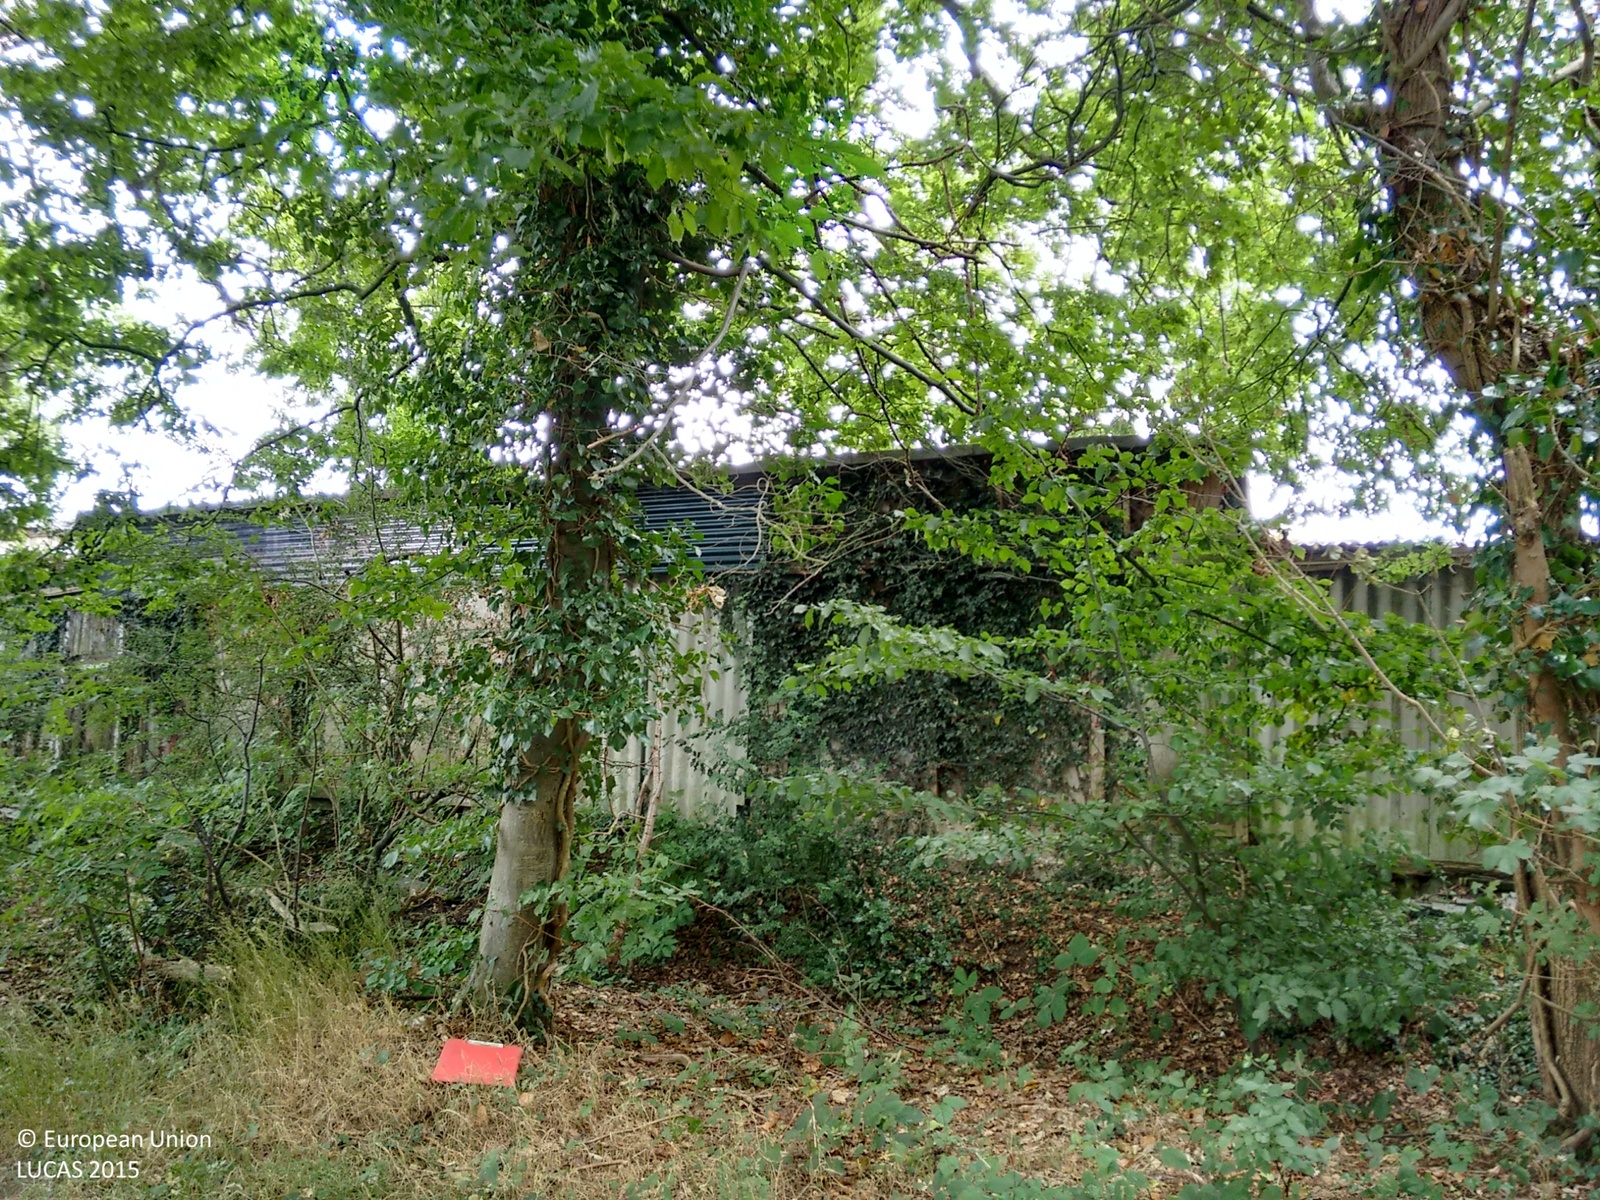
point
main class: Woodland
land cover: Broadleaved woodland
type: mesophytic deciduous forest
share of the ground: 50 - 75 %
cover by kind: broadleaved forest trees 60 %, herbaceous plants 30 %, shrubs 10 %
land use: Semi-natural and natural areas not in use
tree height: > 5 m
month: July
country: GB
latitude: 51.5916
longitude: -0.4158
